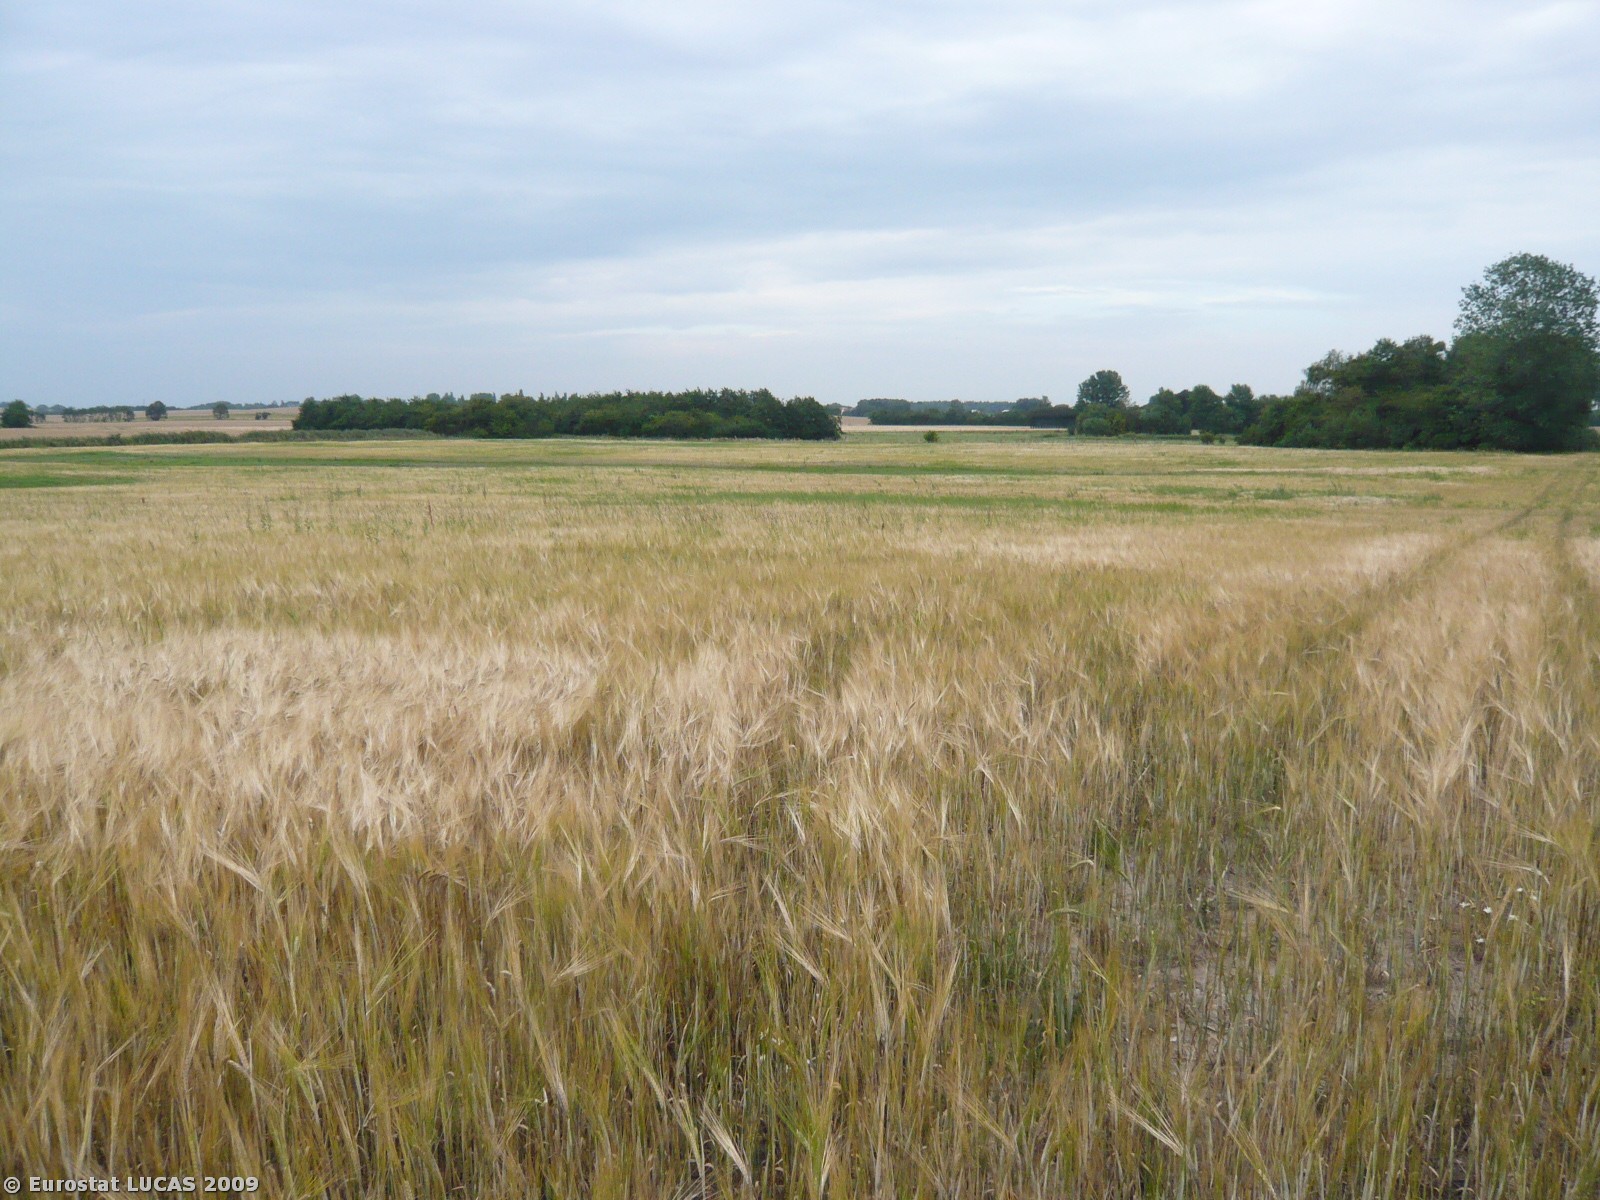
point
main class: Cropland
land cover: Barley
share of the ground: > 75 %
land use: Agriculture (excluding fallow land and kitchen gardens)
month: July
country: DK
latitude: 55.8830
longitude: 12.0923
